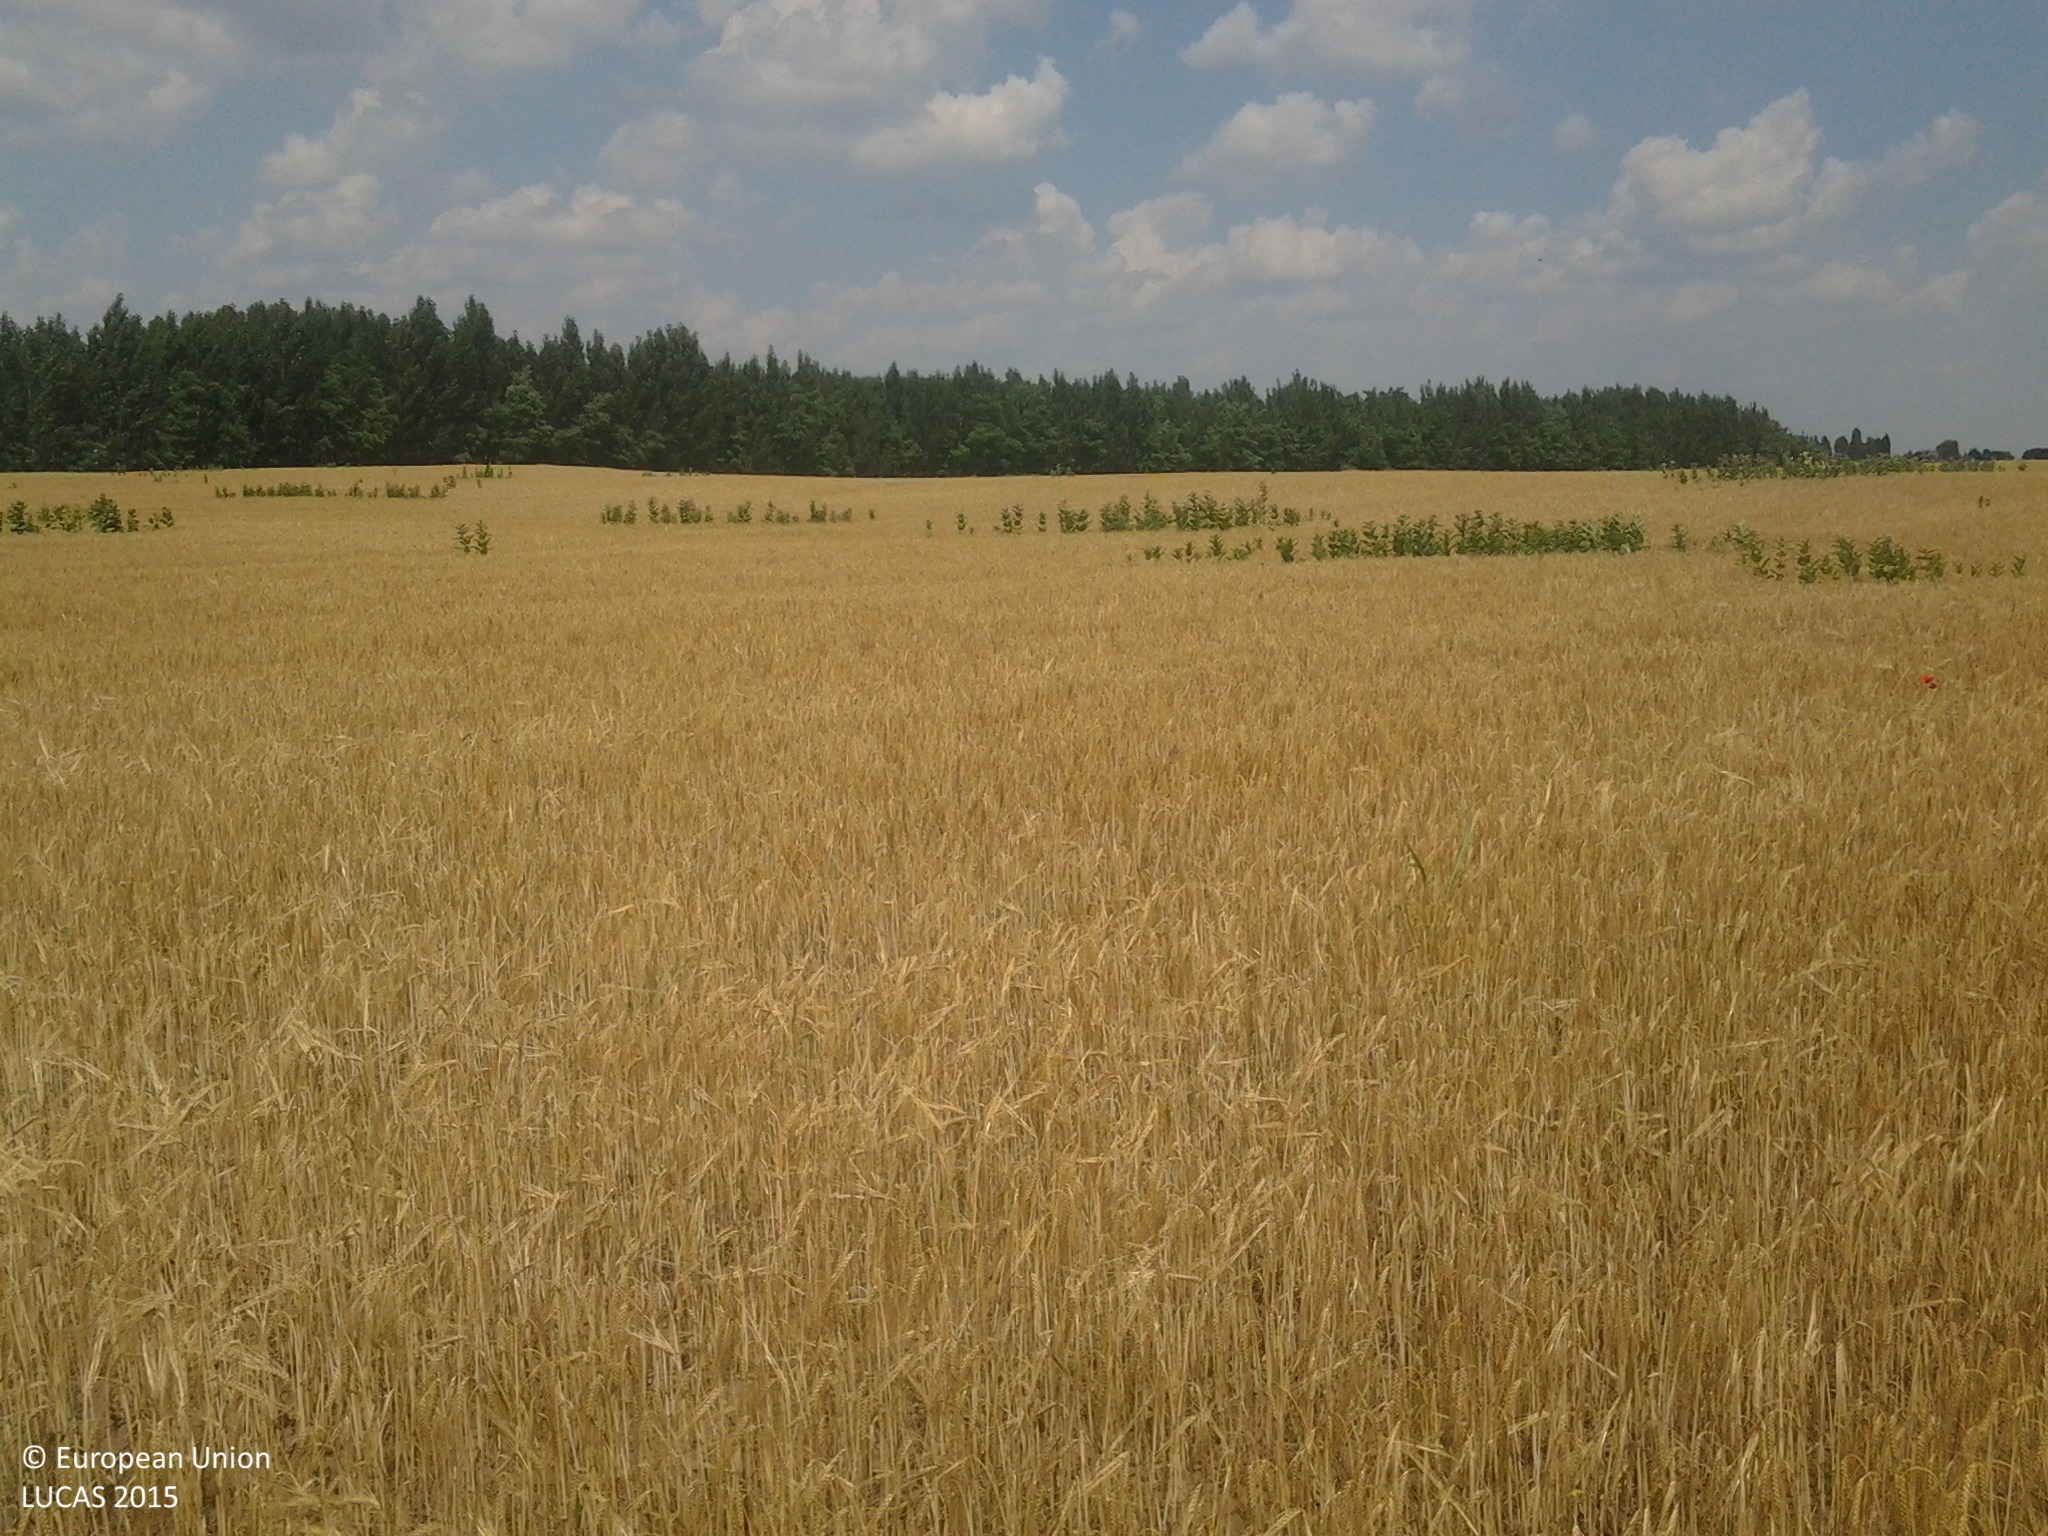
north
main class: Cropland
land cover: Barley
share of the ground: > 75 %
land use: Agriculture (excluding fallow land and kitchen gardens)
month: June
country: HU
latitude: 46.8155
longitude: 19.7059
